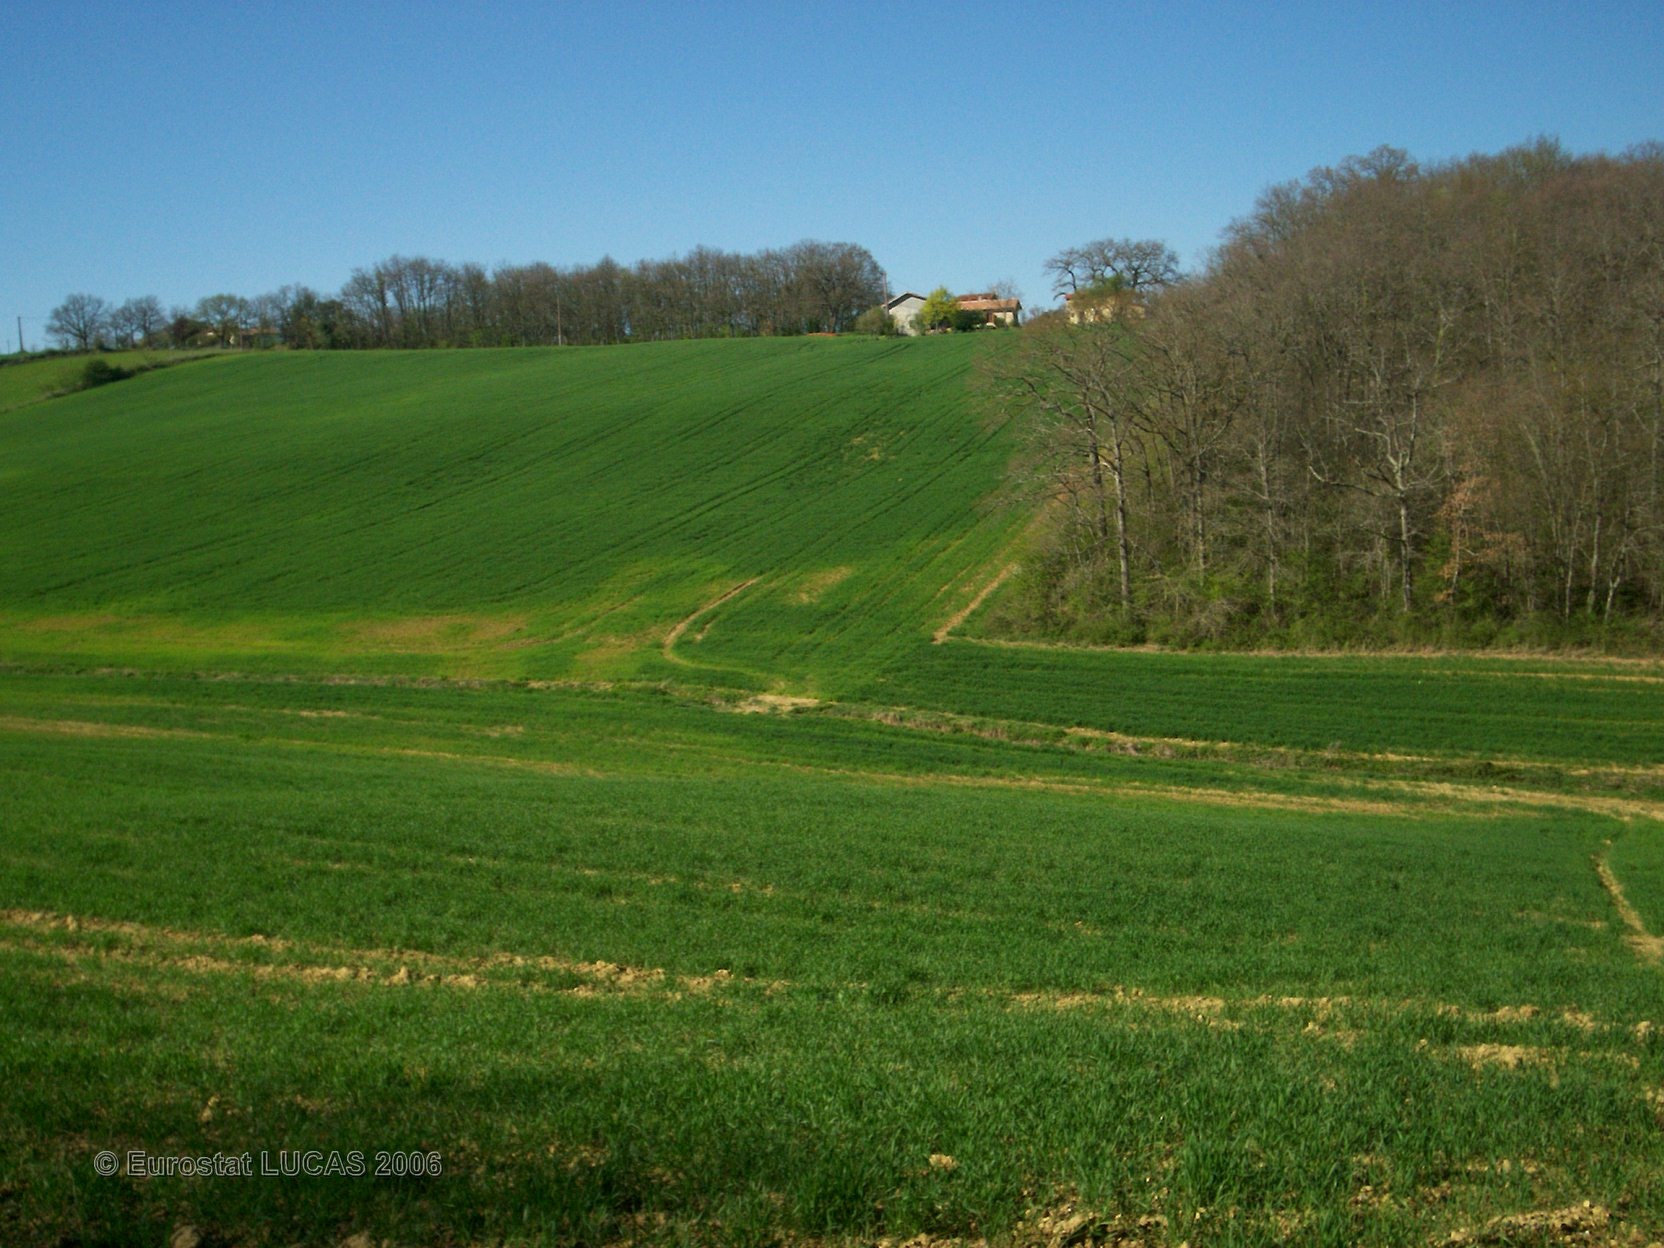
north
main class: Cropland
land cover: Common wheat
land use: Agriculture (excluding fallow land and kitchen gardens)
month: April
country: FR
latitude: 43.5506
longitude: 0.3046
